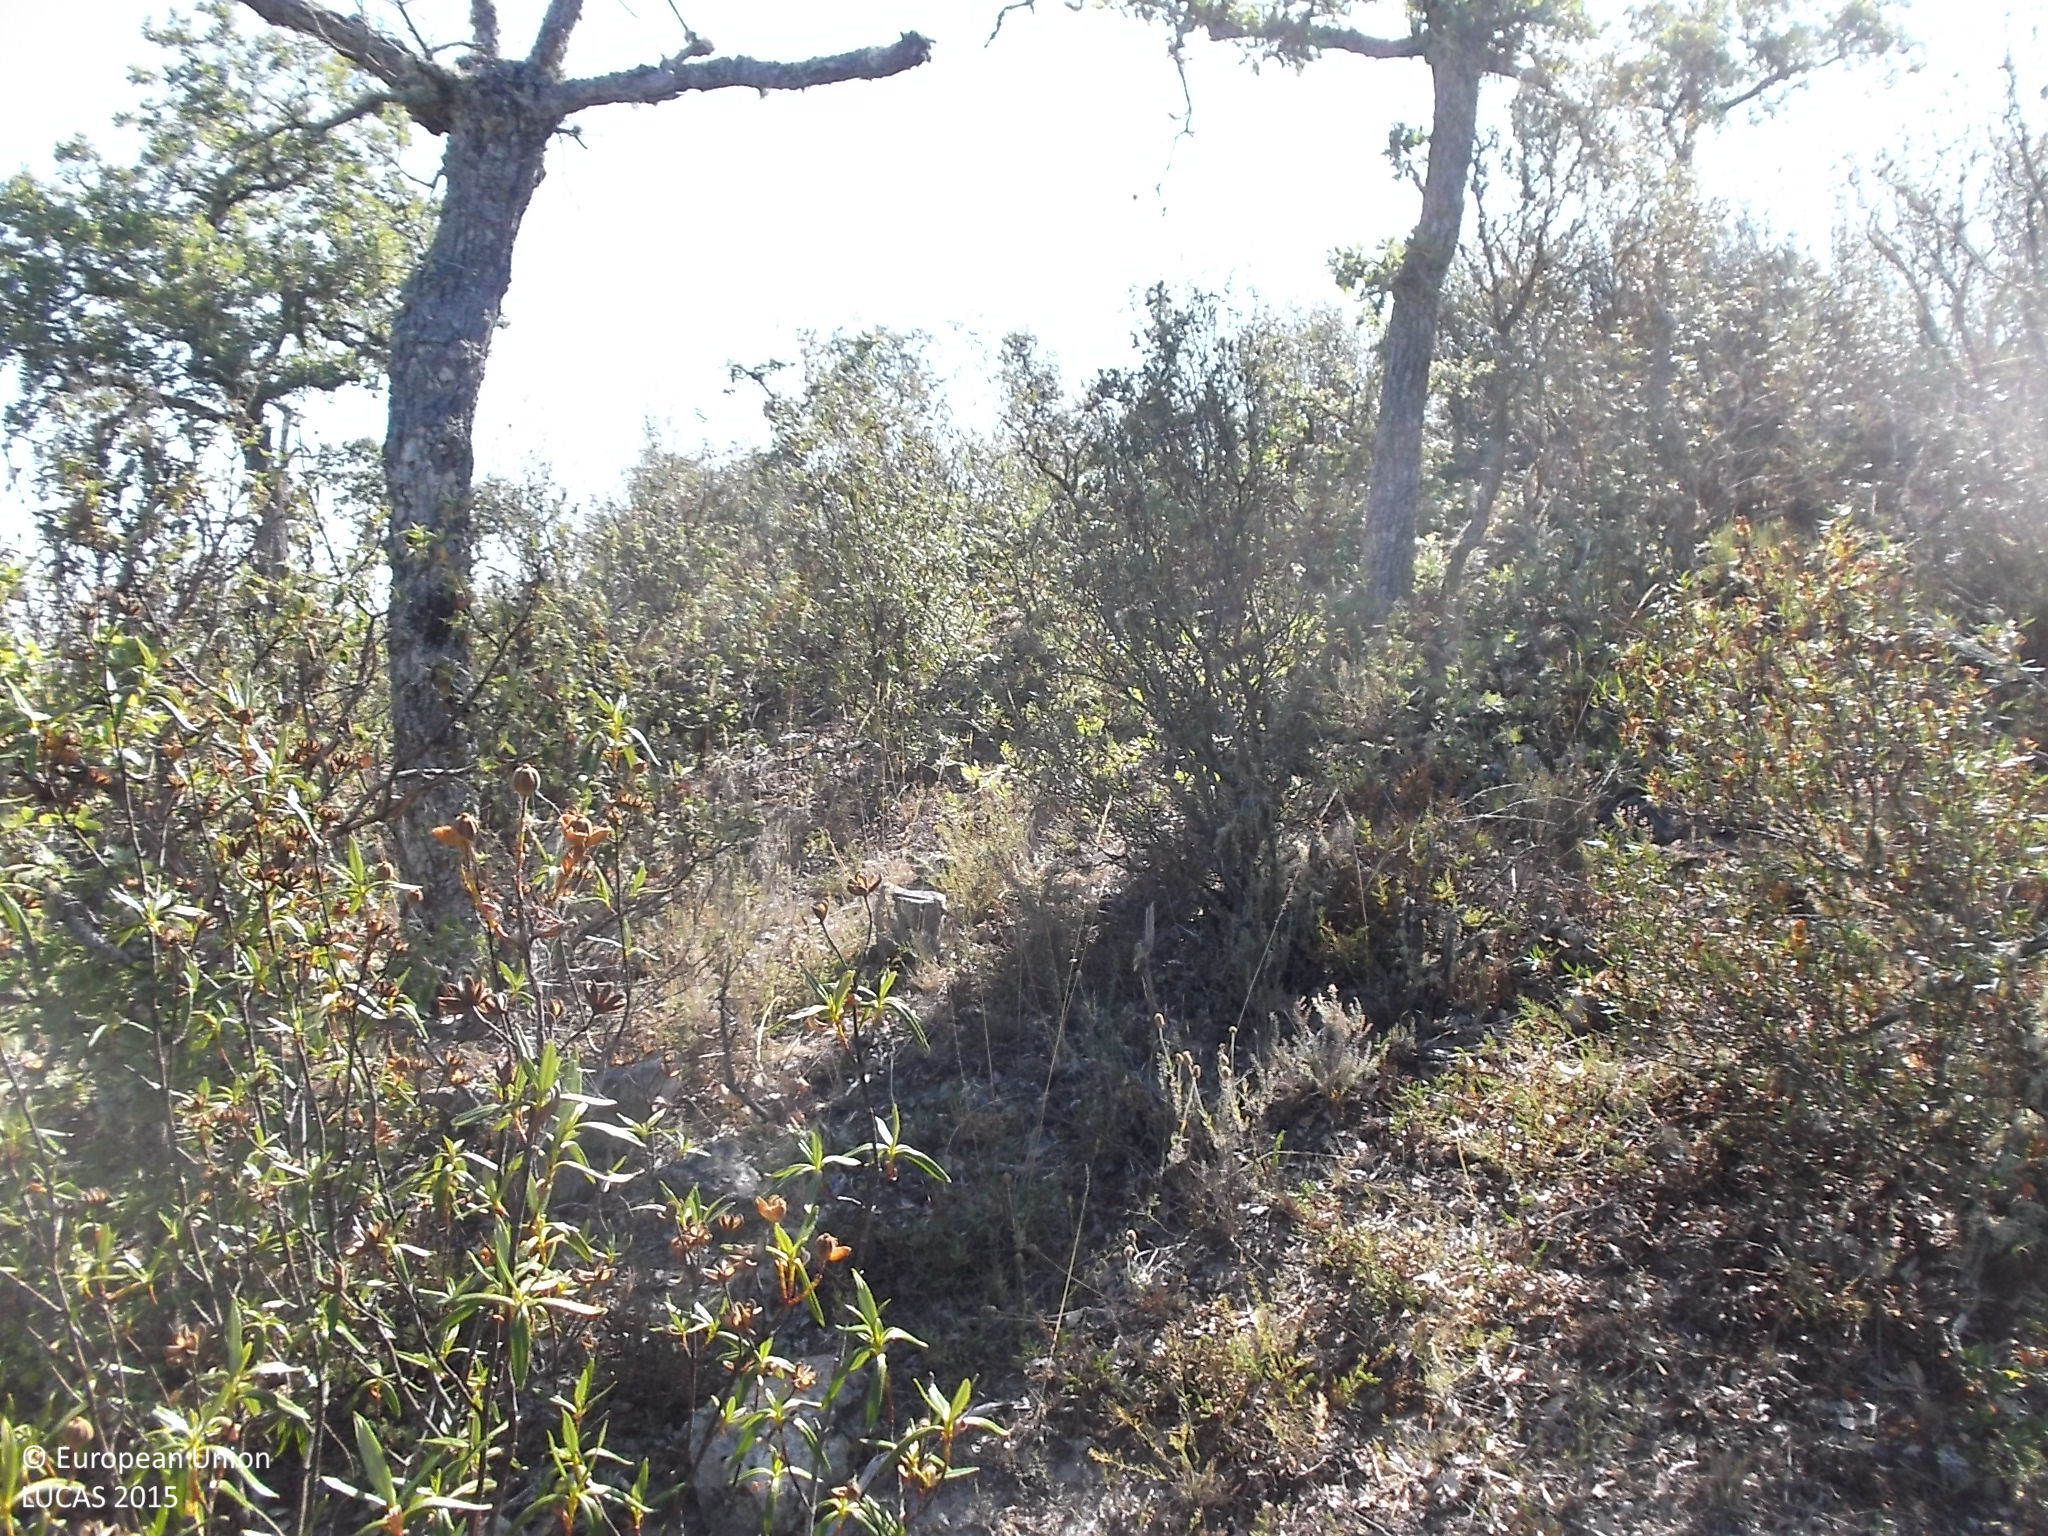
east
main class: Woodland
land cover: Broadleaved woodland
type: broadleaved evergreen forest
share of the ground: 10 - 25 %
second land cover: Shrubland without tree cover
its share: 50 - 75 %
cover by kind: shrubs 80 %, broadleaved forest trees 20 %
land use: Forestry
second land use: Agriculture (excluding fallow land and kitchen gardens)
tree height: < 5 m
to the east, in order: Broadleaved woodland; Shrubland without tree cover; Grassland without tree/shrub cover; Shrubland without tree cover
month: July
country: ES
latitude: 41.2889
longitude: -5.8352
